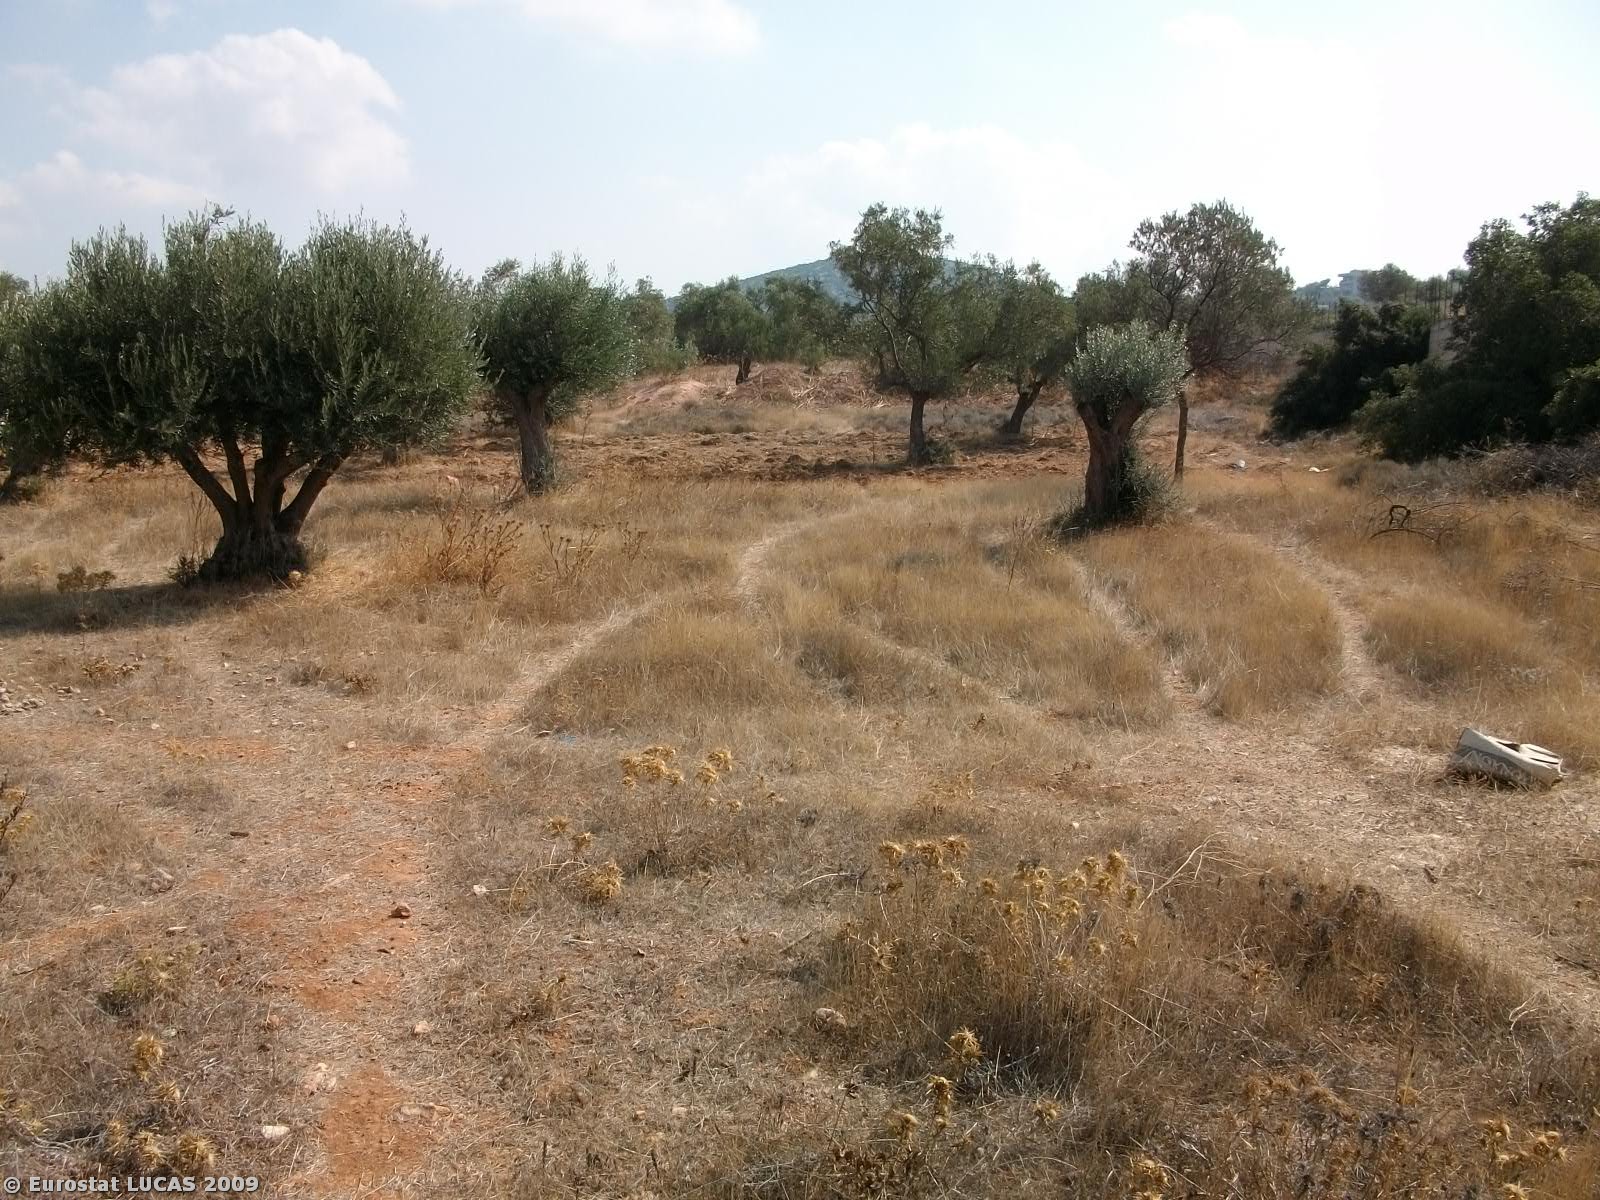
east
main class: Cropland
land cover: Olive groves
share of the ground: 10 - 25 %
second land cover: Grassland with sparse tree/shrub cover
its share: > 75 %
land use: Agriculture (excluding fallow land and kitchen gardens)
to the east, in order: Olive groves; Grassland with sparse tree/shrub cover; Fences; Olive groves; Grassland with sparse tree/shrub cover; Fences; Grassland without tree/shrub cover; Olive groves; Grassland with sparse tree/shrub cover
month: October
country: GR
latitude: 37.8805
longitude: 23.8855
